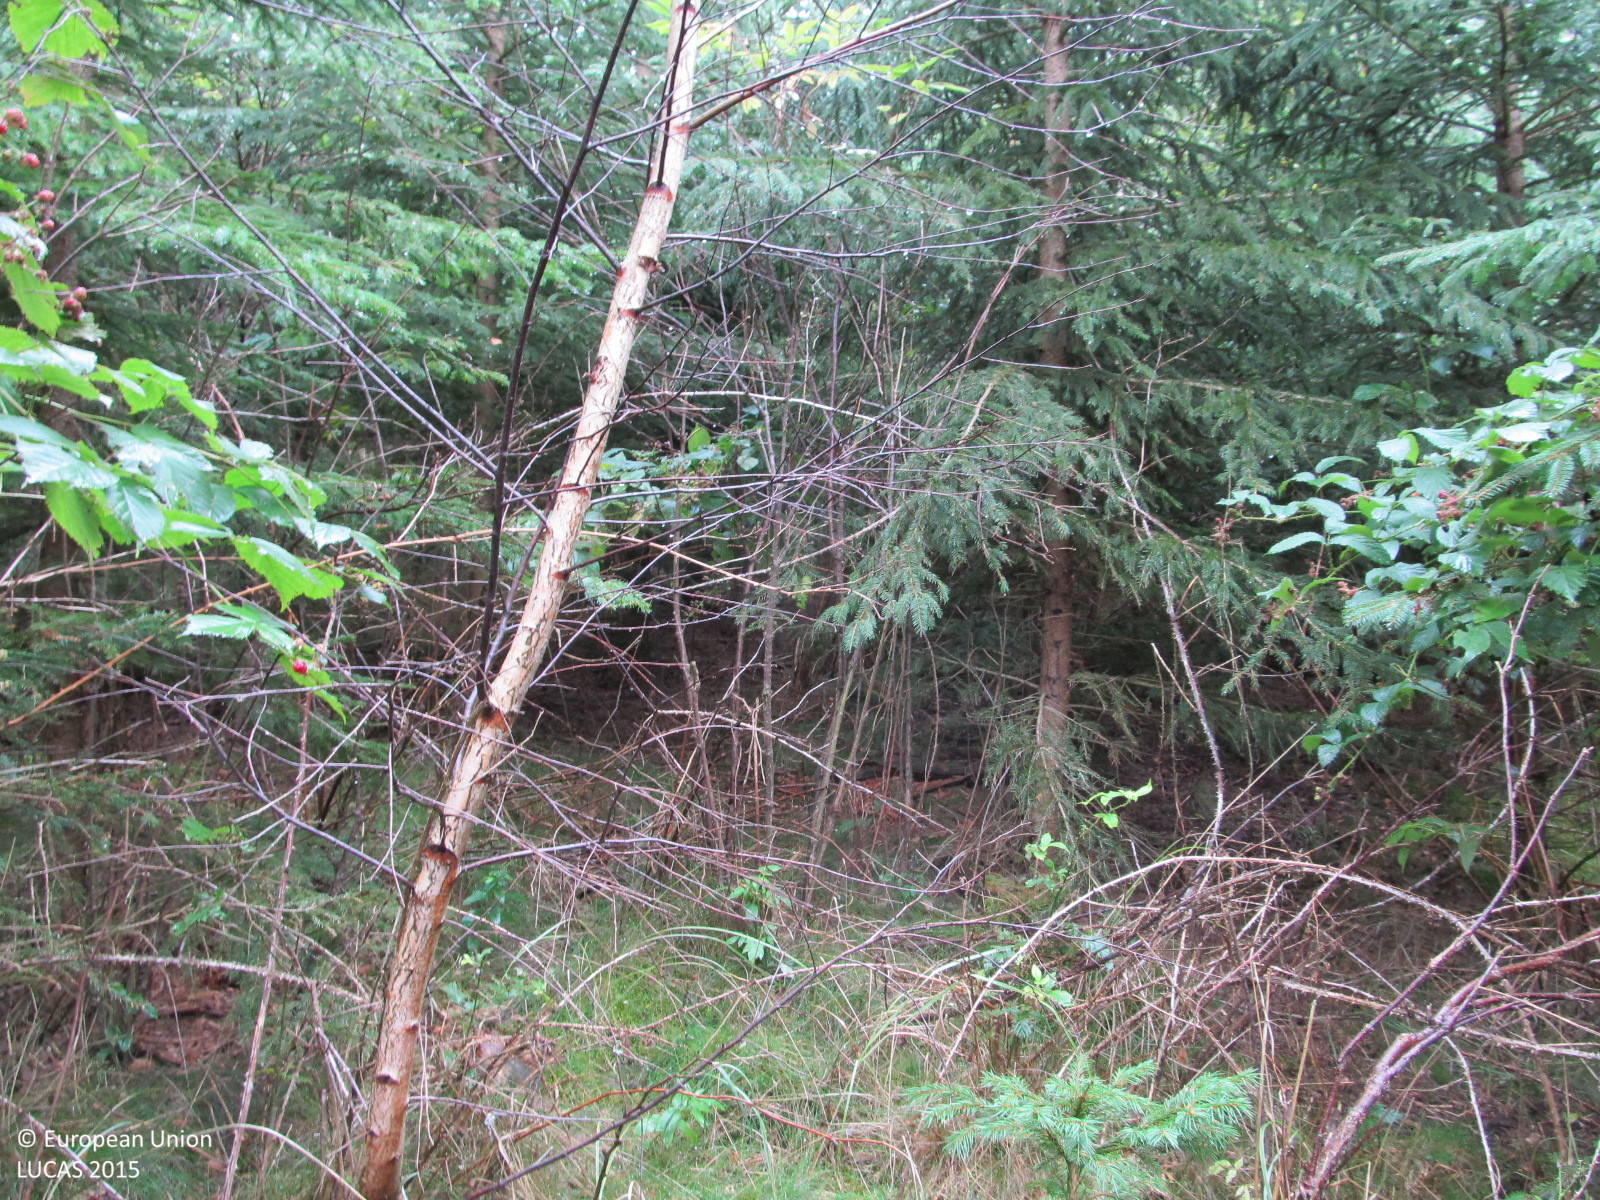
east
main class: Woodland
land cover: Spruce dominated coniferous woodland
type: hemiboreal forest and nemoral coniferous forest and mixed broadleaved-coniferous forest
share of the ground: > 75 %
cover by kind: coniferous forest trees 90 %, herbaceous plants 5 %, unconsolidated bare surface 5 %
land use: Forestry
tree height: > 5 m
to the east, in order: Spruce dominated coniferous woodland; Grassland without tree/shrub cover; Spruce dominated coniferous woodland; Tracks; Spruce dominated coniferous woodland
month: September
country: AT
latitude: 48.3570
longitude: 15.4953
